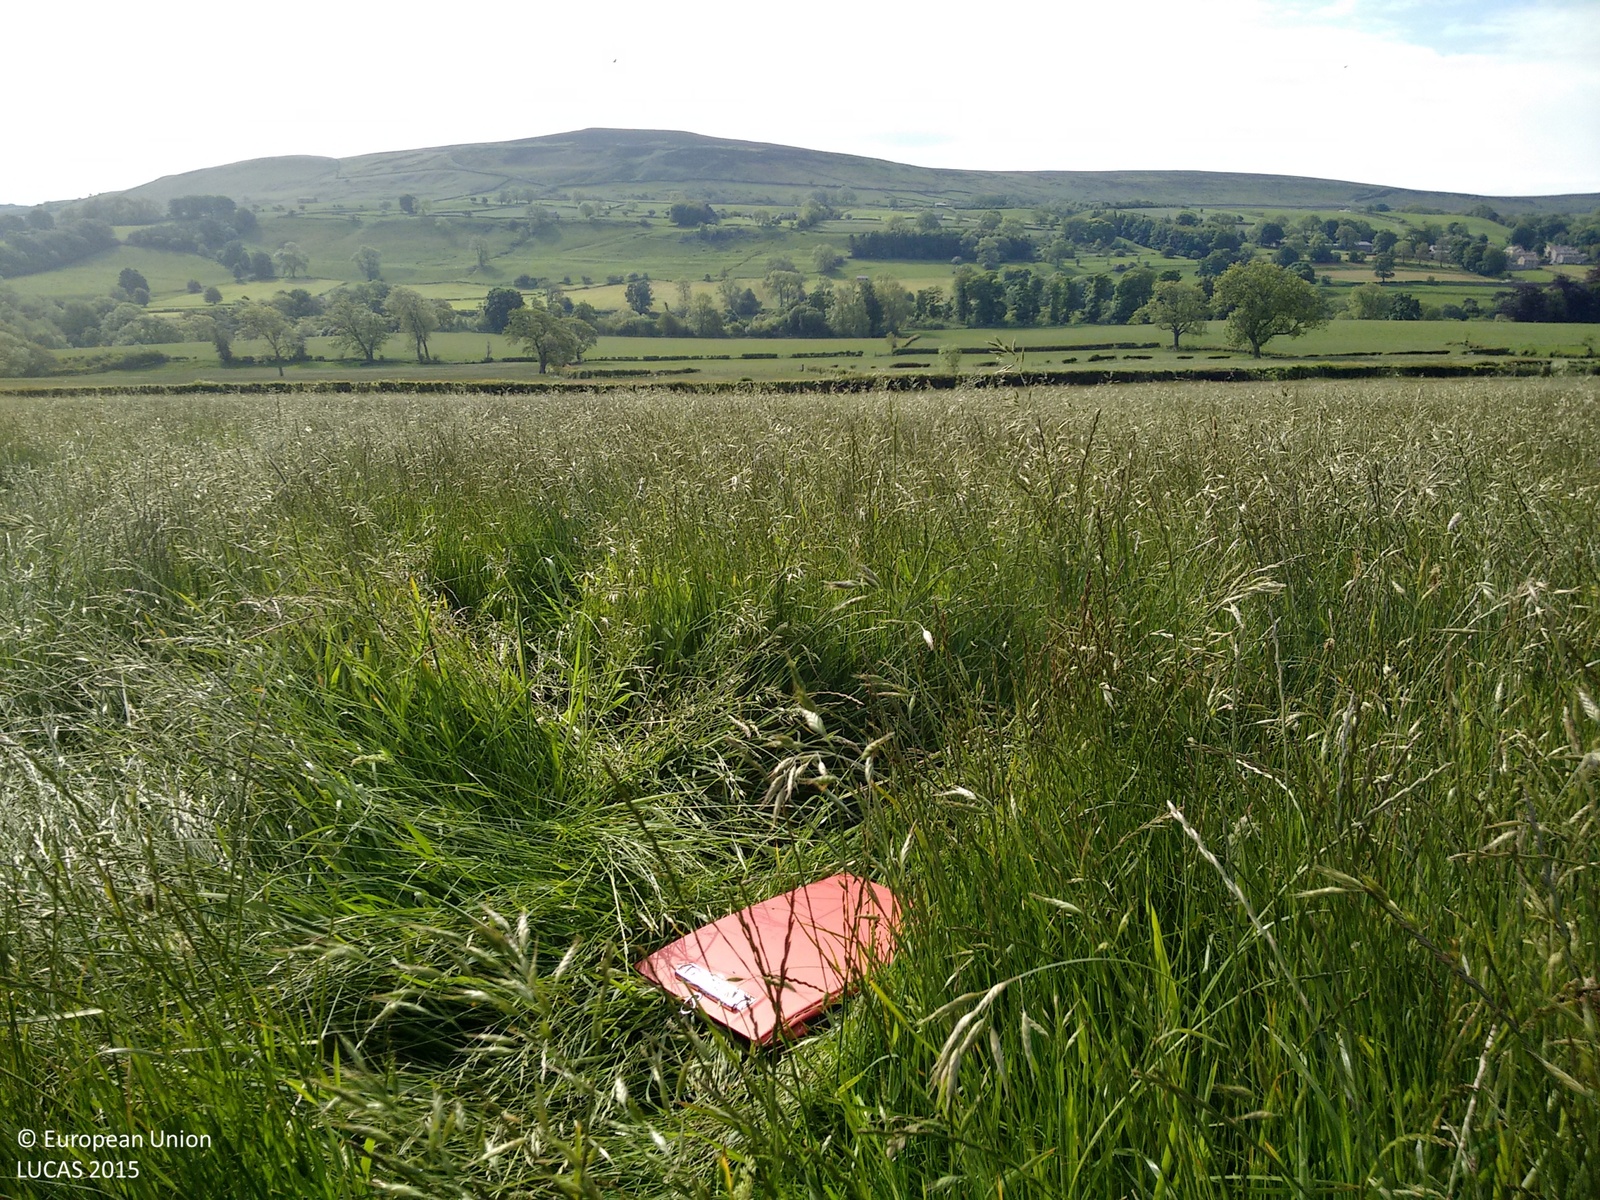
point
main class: Grassland
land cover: Grassland without tree/shrub cover
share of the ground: > 75 %
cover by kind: herbaceous plants 100 %
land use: Agriculture (excluding fallow land and kitchen gardens)
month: June
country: GB
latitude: 54.2710
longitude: -1.8626
